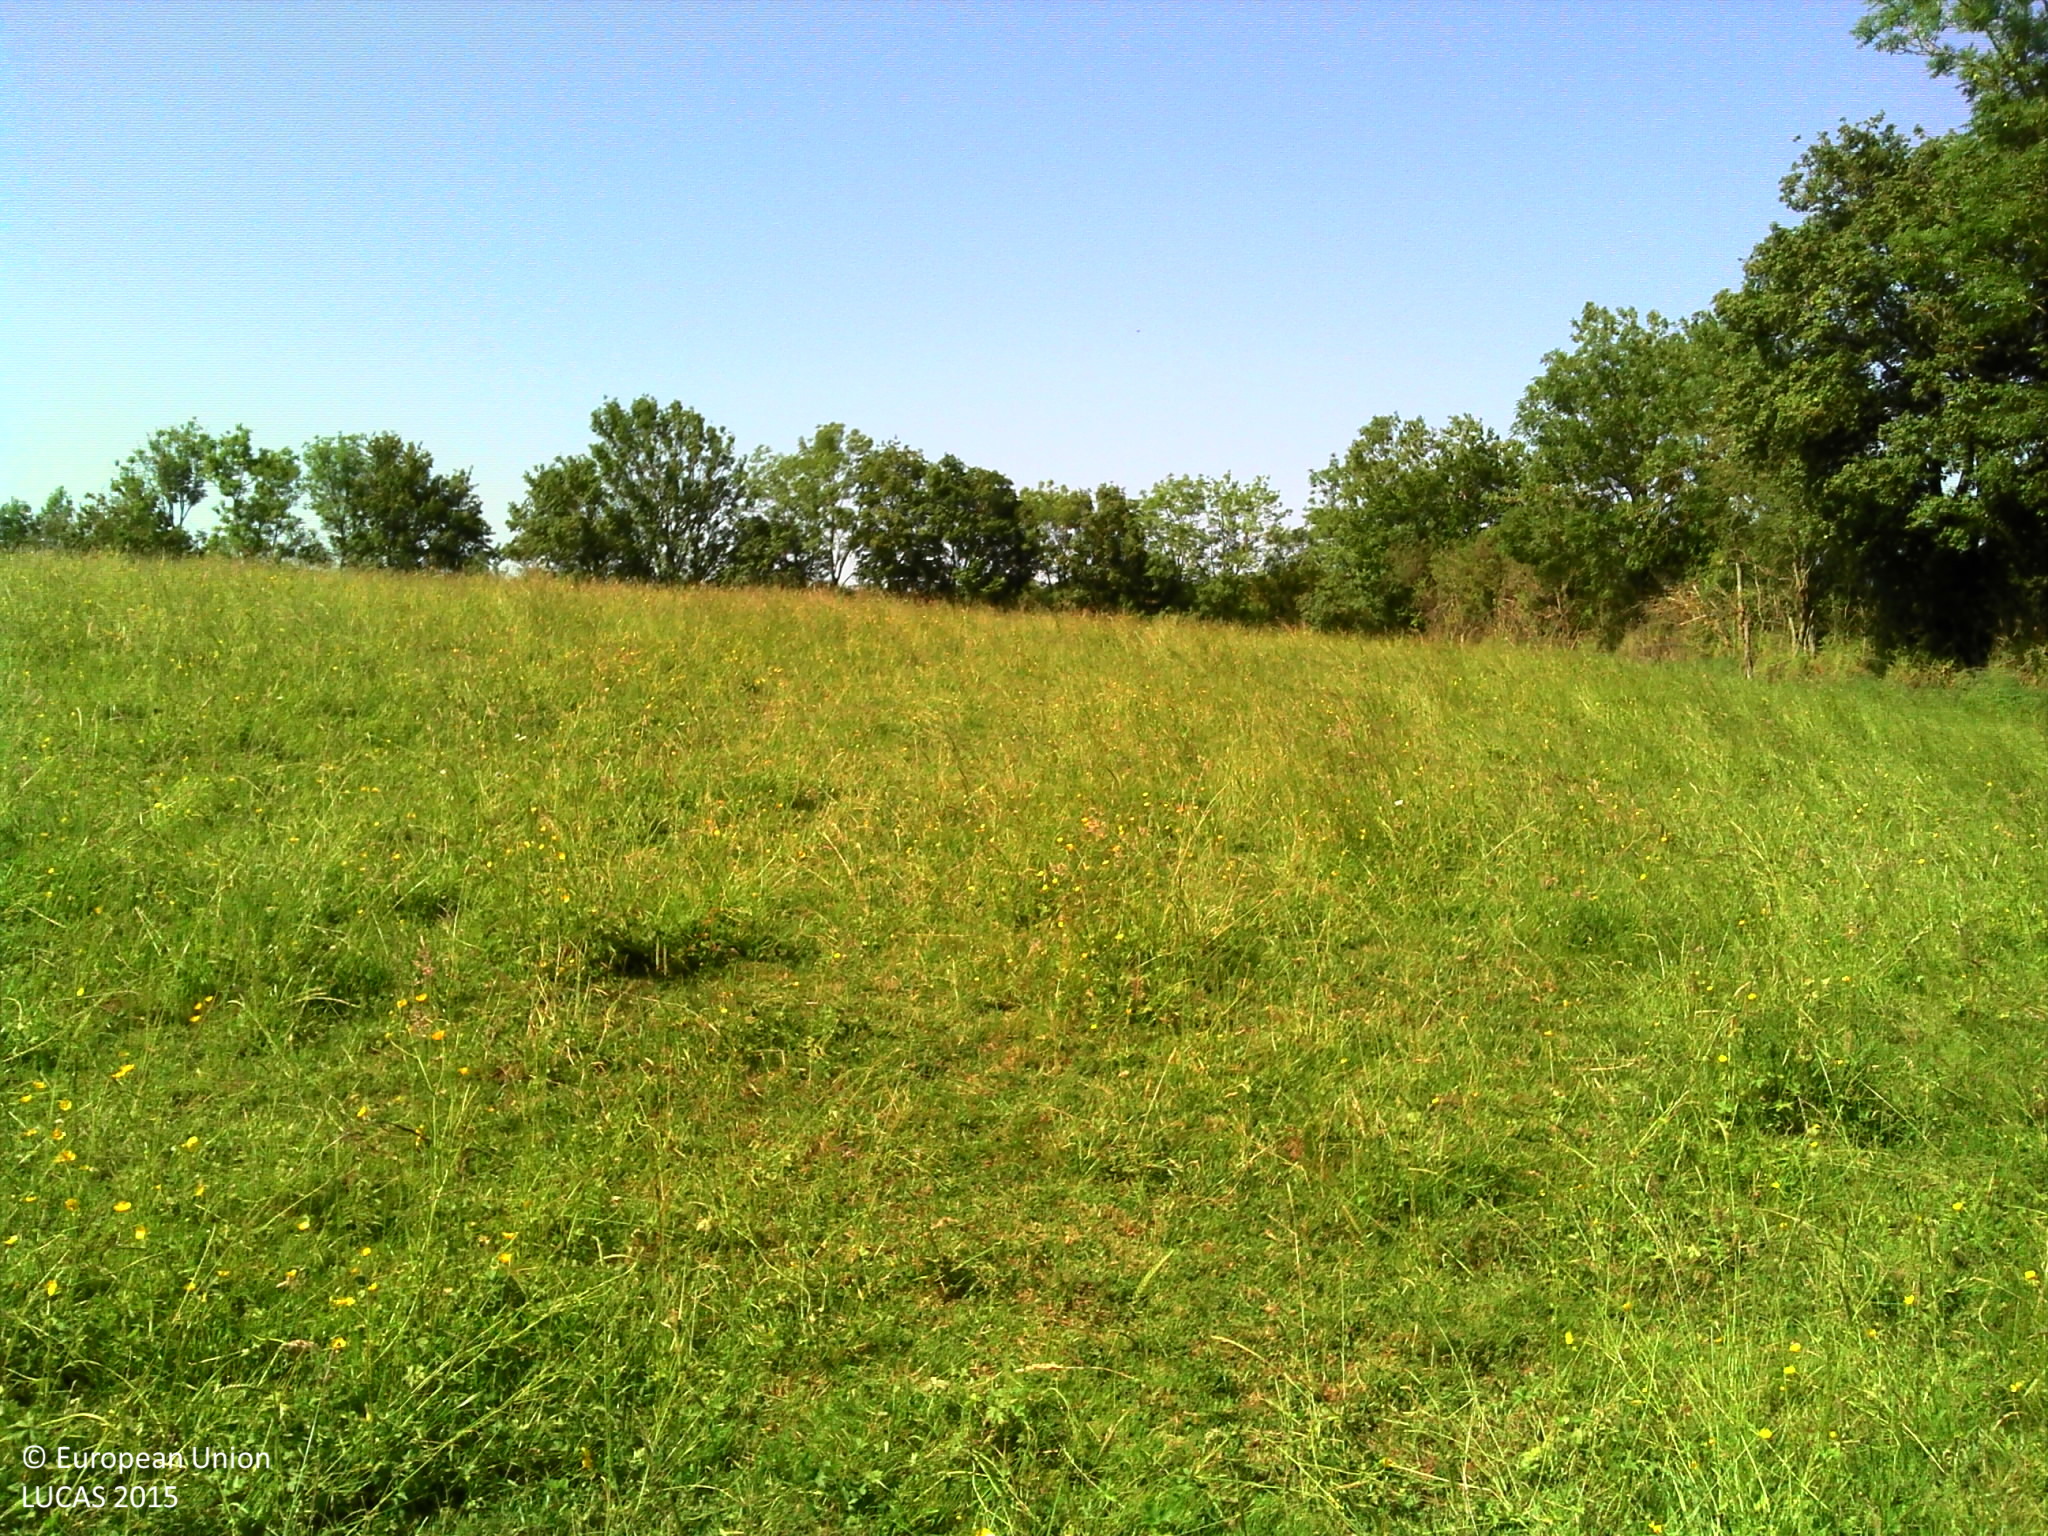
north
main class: Grassland
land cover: Grassland without tree/shrub cover
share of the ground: > 75 %
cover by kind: herbaceous plants 100 %
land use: Agriculture (excluding fallow land and kitchen gardens)
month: June
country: FR
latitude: 46.8672
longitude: 2.7930
